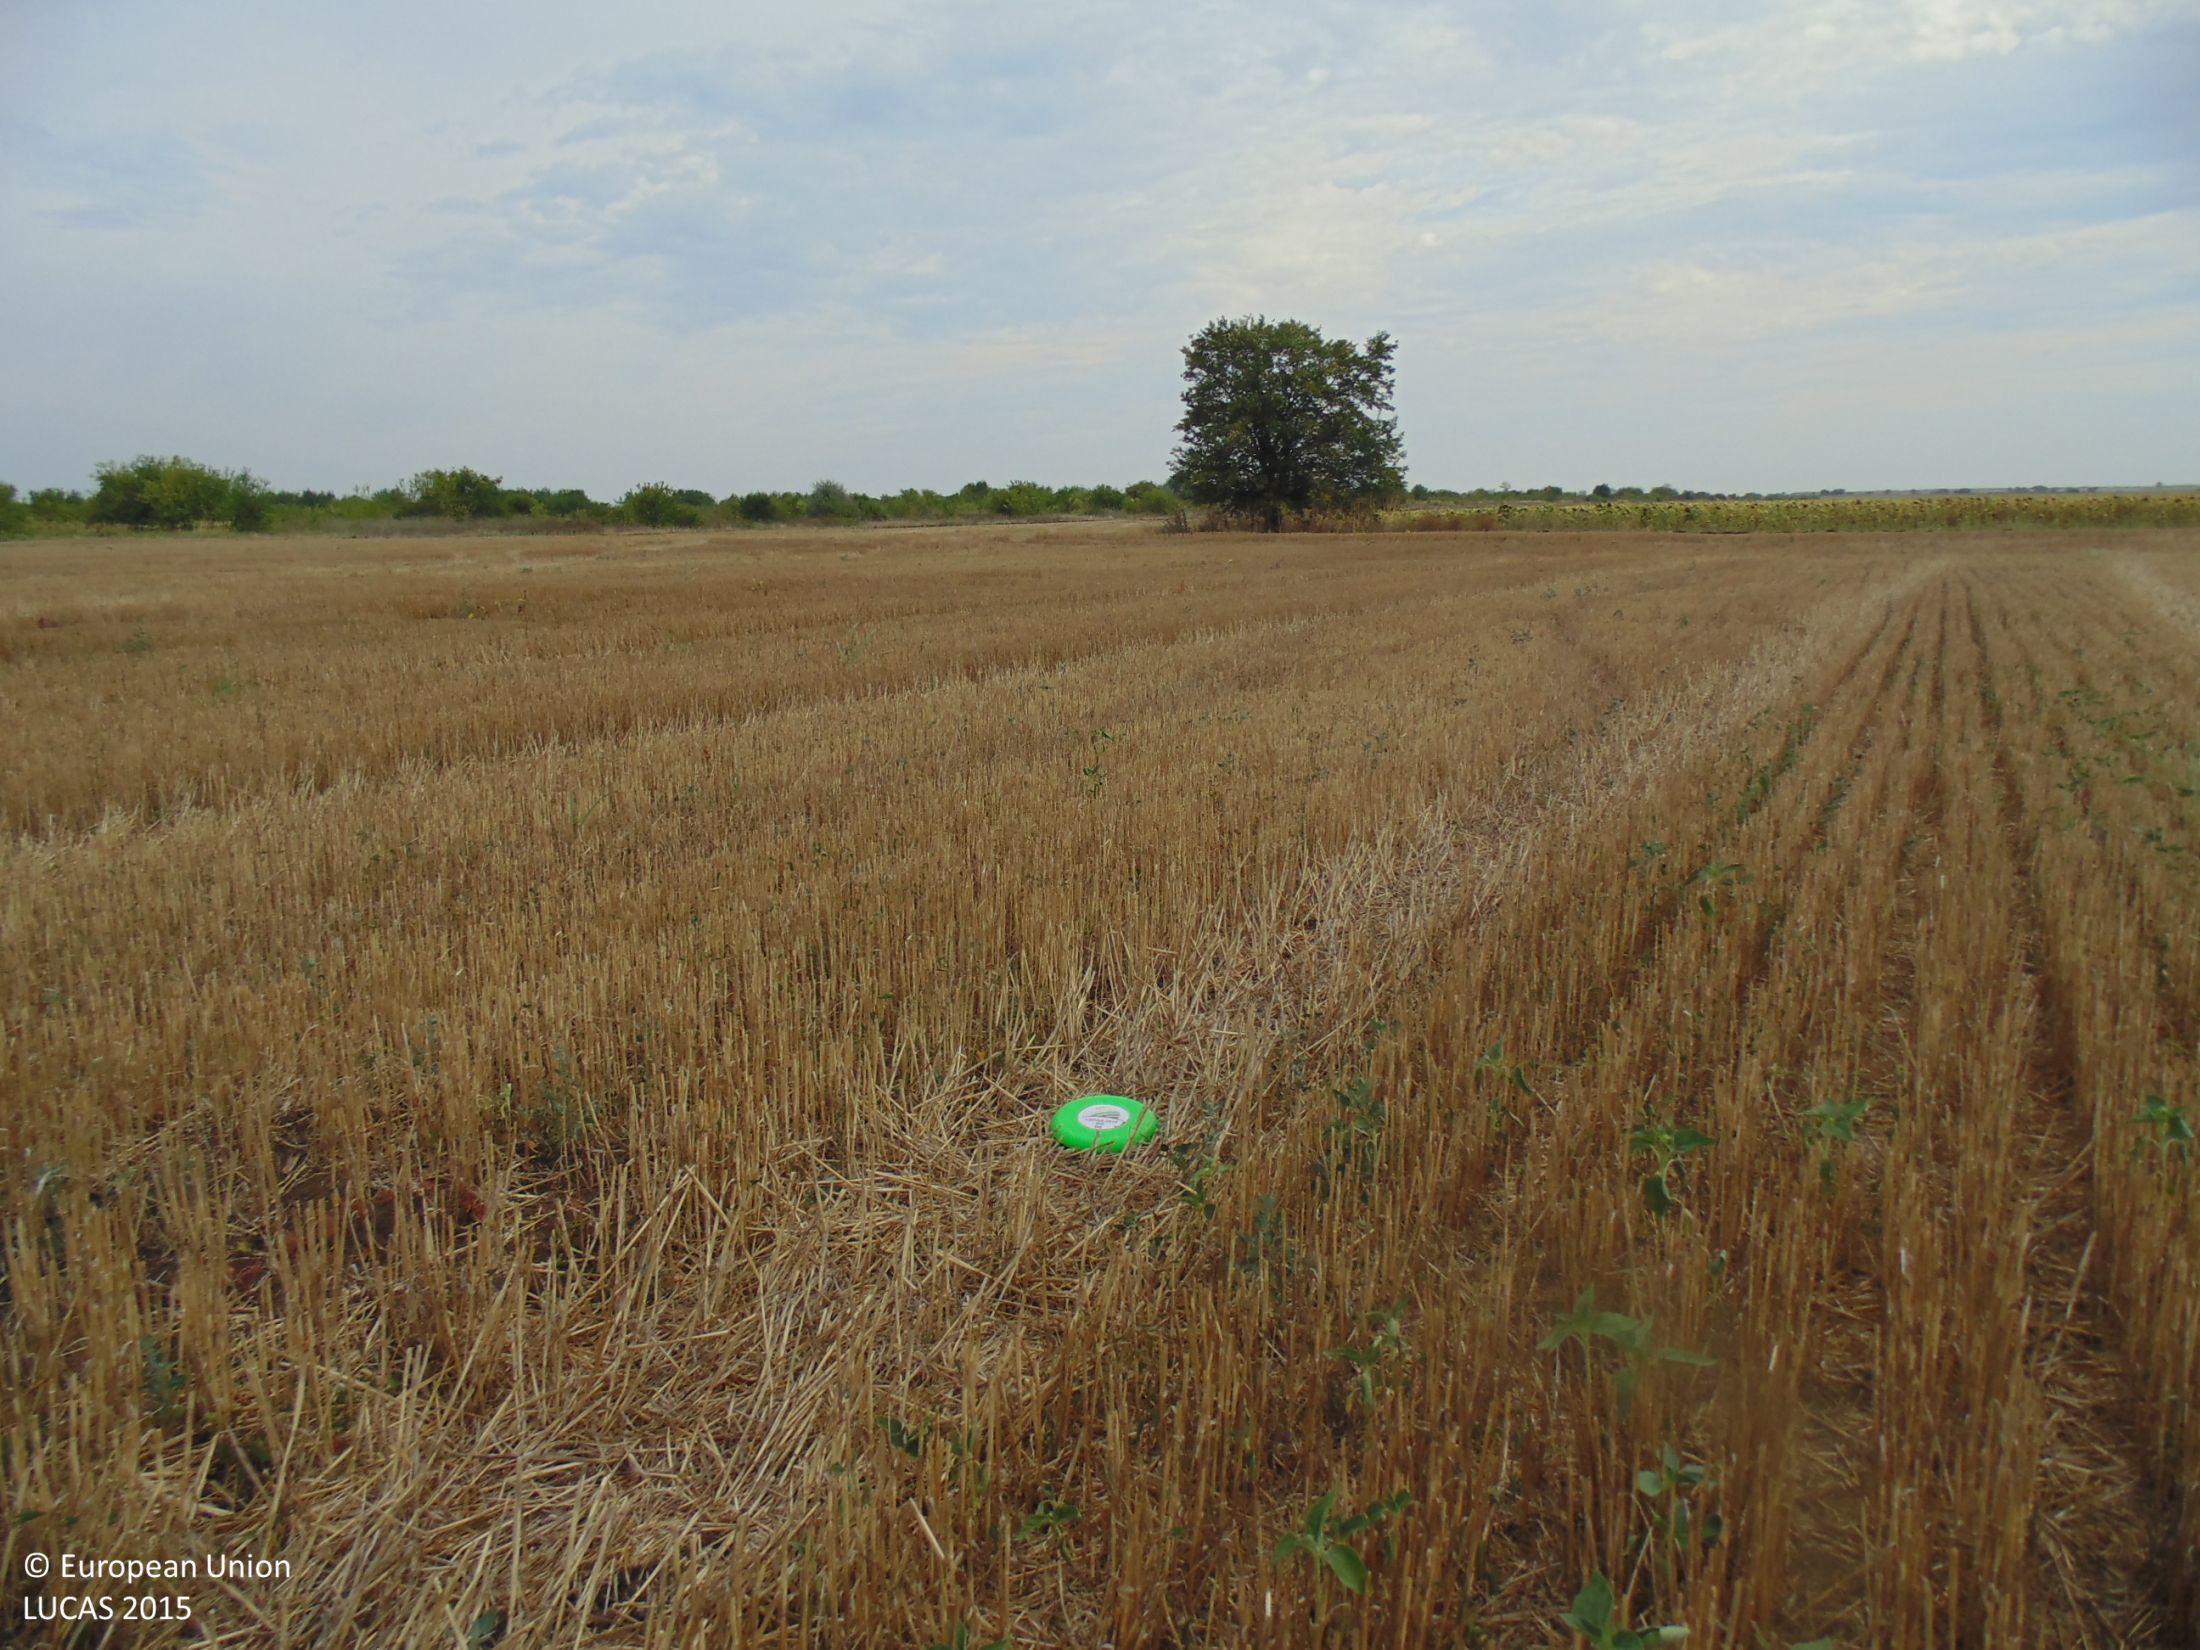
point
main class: Cropland
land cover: Common wheat
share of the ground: 50 - 75 %
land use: Agriculture (excluding fallow land and kitchen gardens)
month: August
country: BG
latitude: 43.5607
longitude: 28.5730
